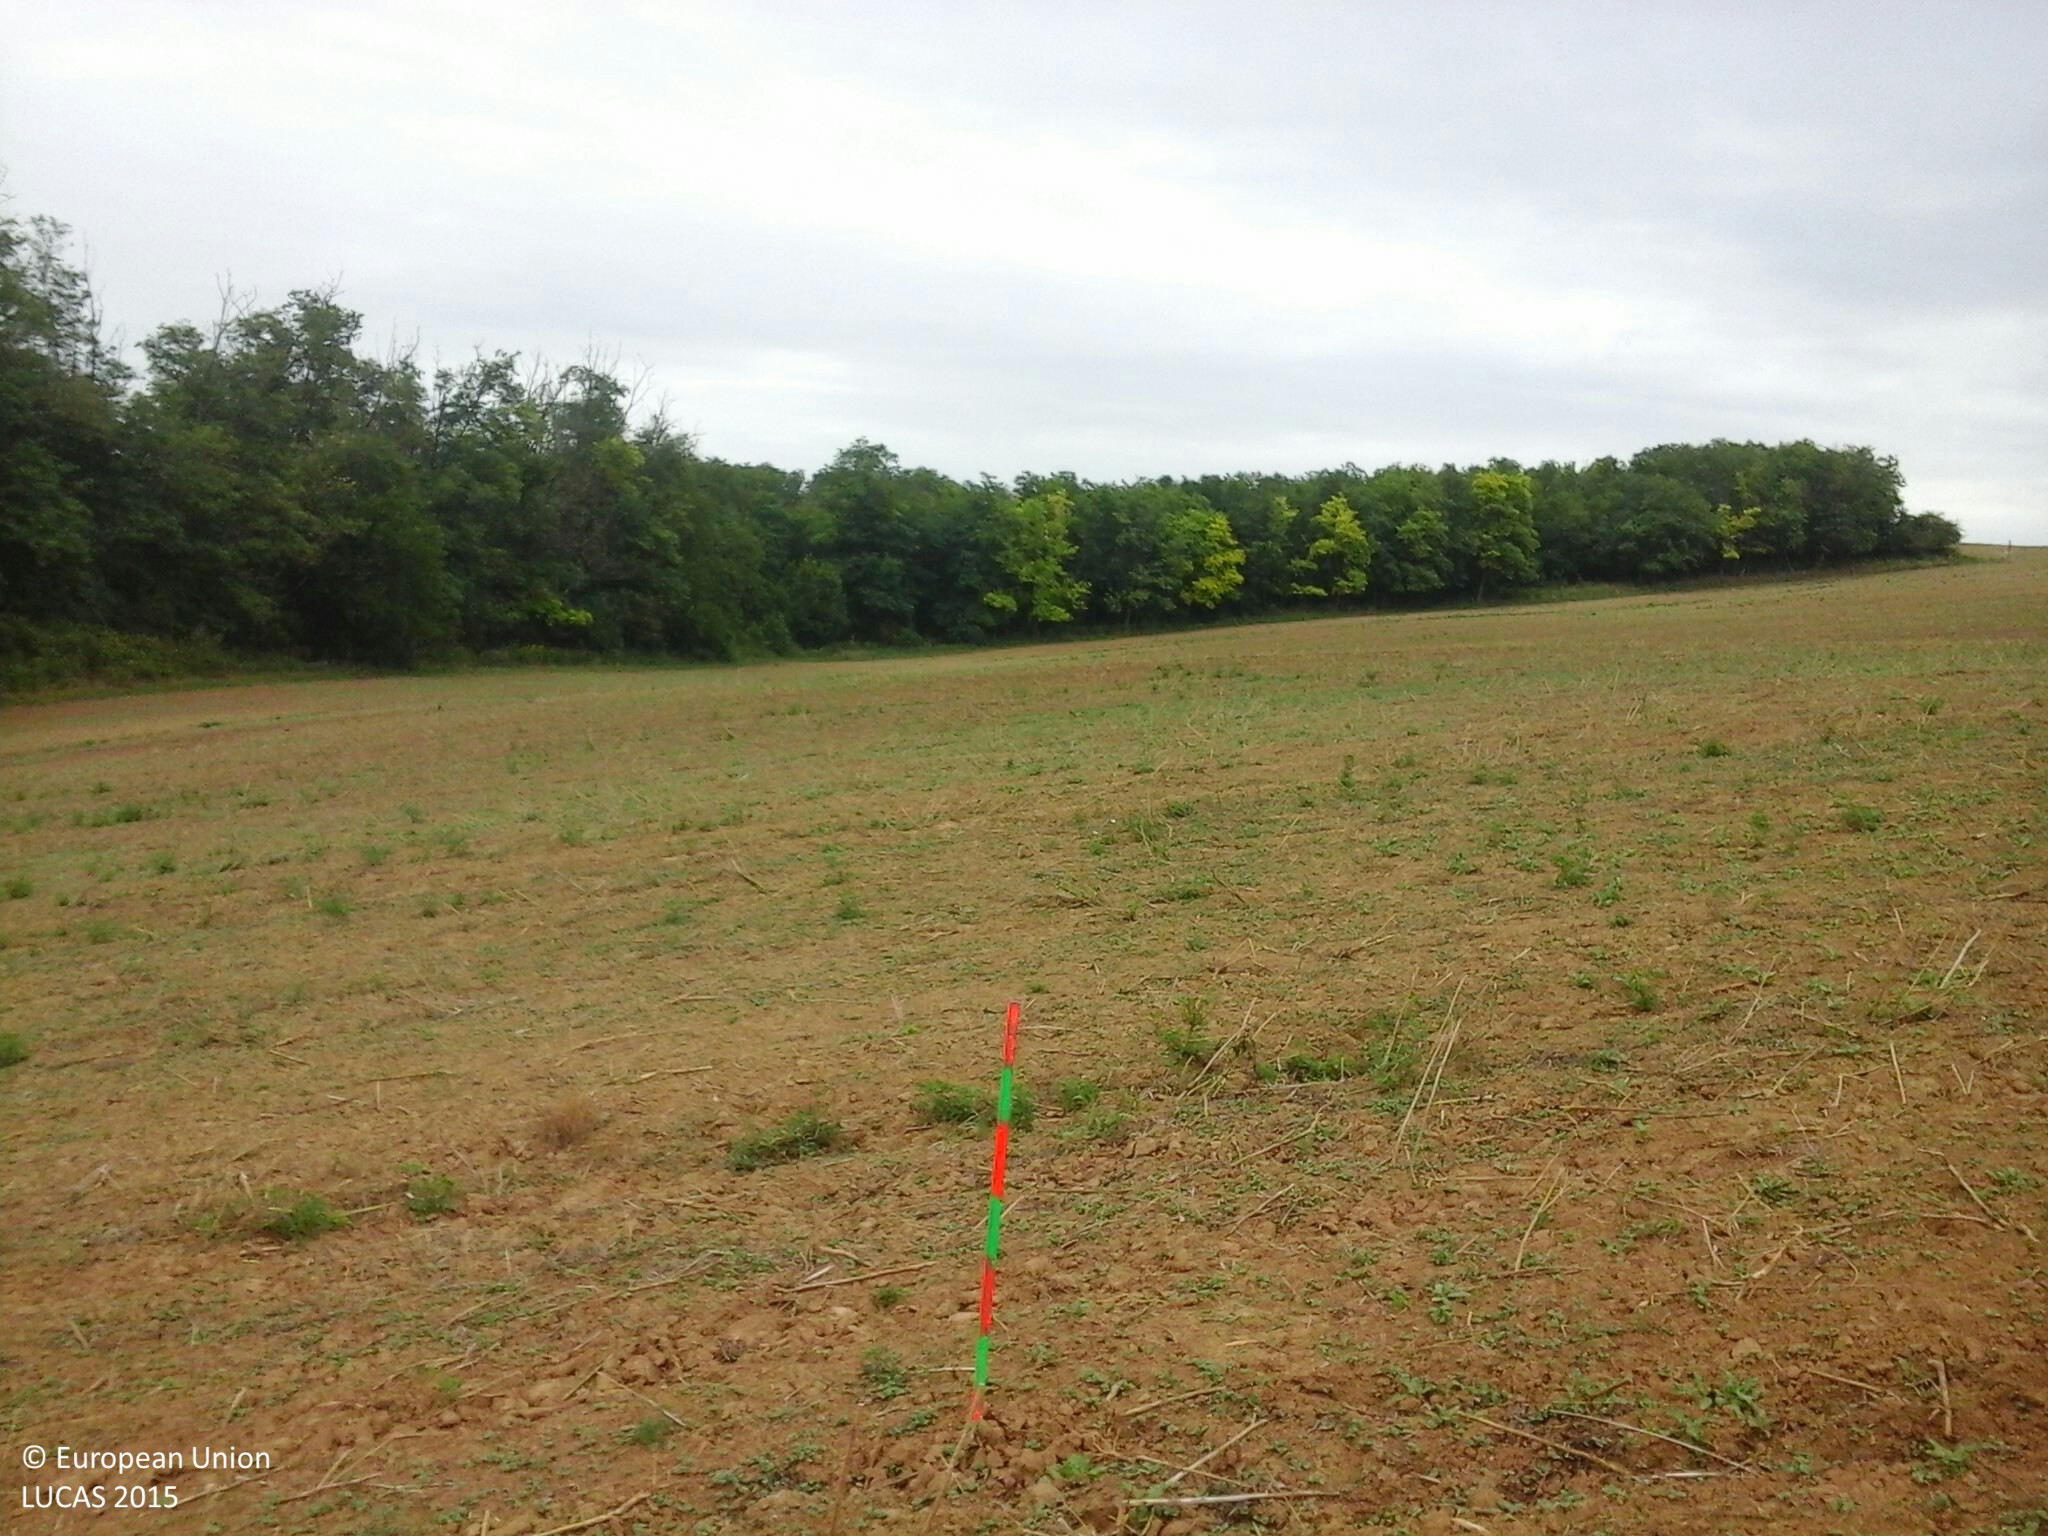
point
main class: Cropland
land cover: Rape and turnip rape
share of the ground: < 10 %
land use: Agriculture (excluding fallow land and kitchen gardens)
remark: Harvested field
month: July
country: HU
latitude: 46.7302
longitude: 17.8719
